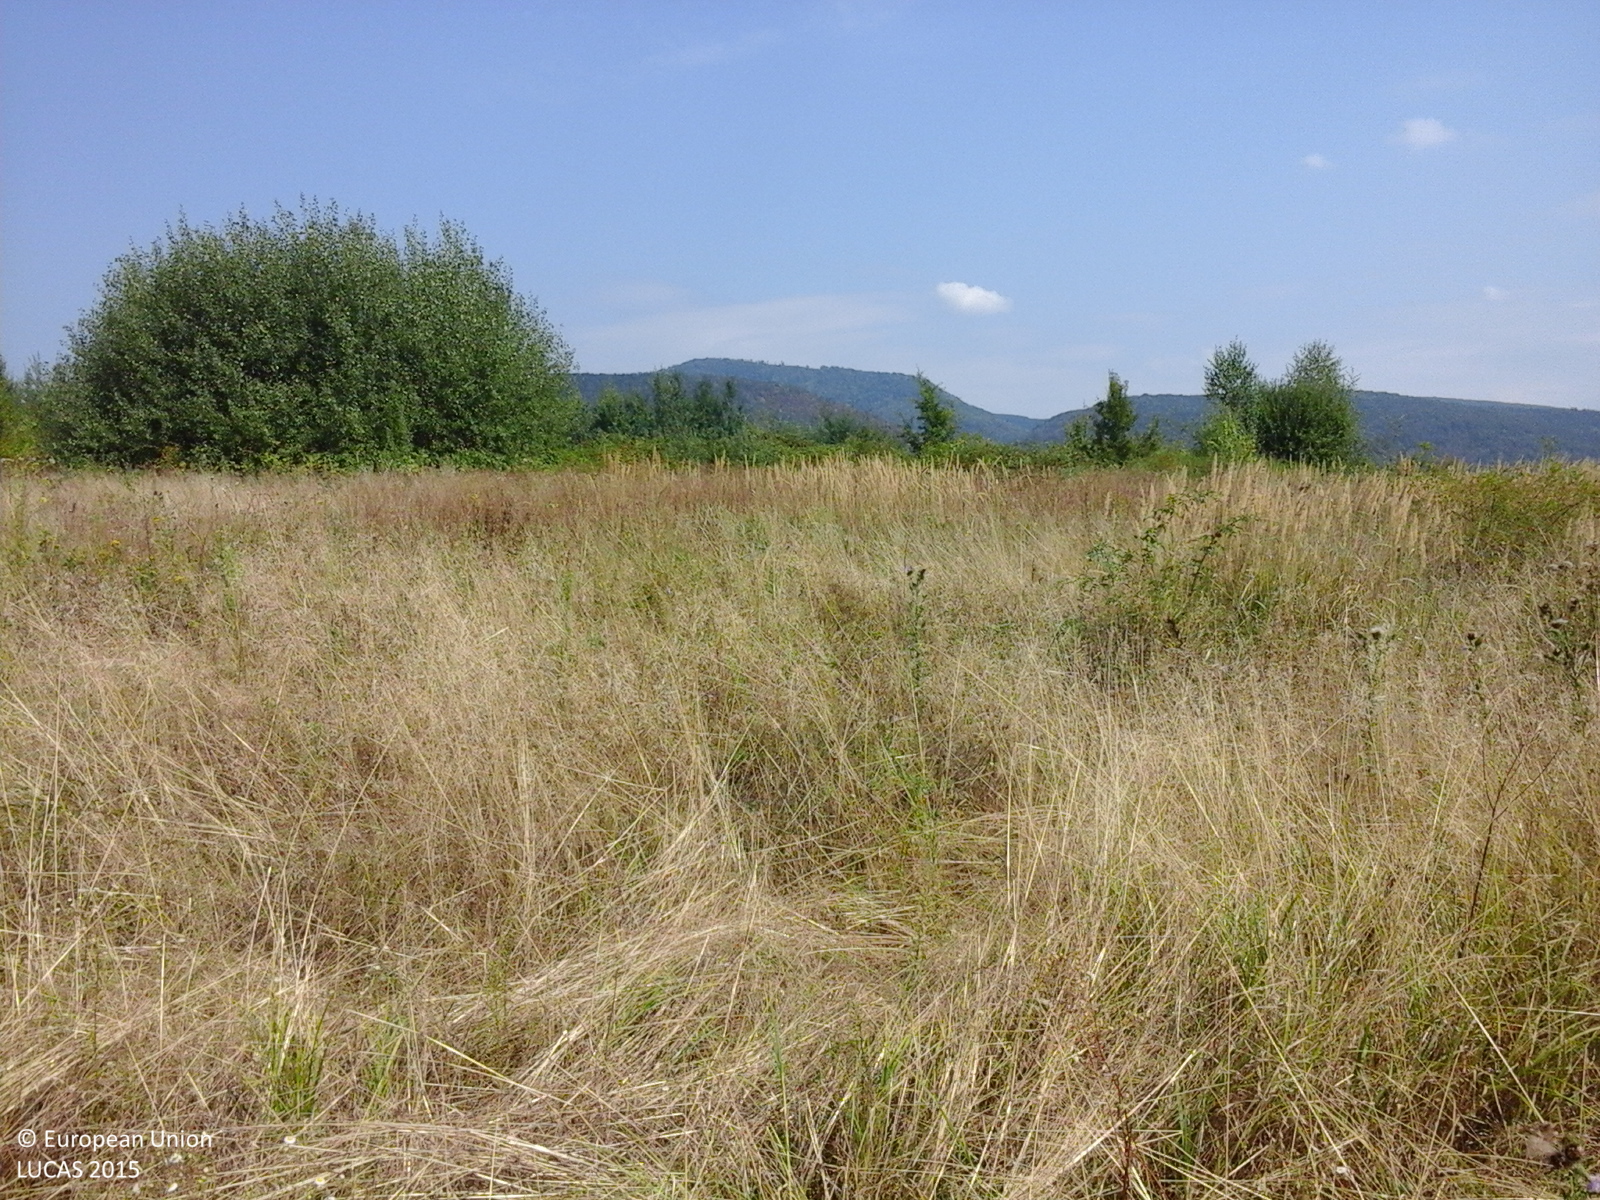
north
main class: Grassland
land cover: Grassland without tree/shrub cover
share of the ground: > 75 %
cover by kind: herbaceous plants 100 %
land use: Agriculture (excluding fallow land and kitchen gardens)
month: August
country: RO
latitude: 46.3335
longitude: 22.2714
